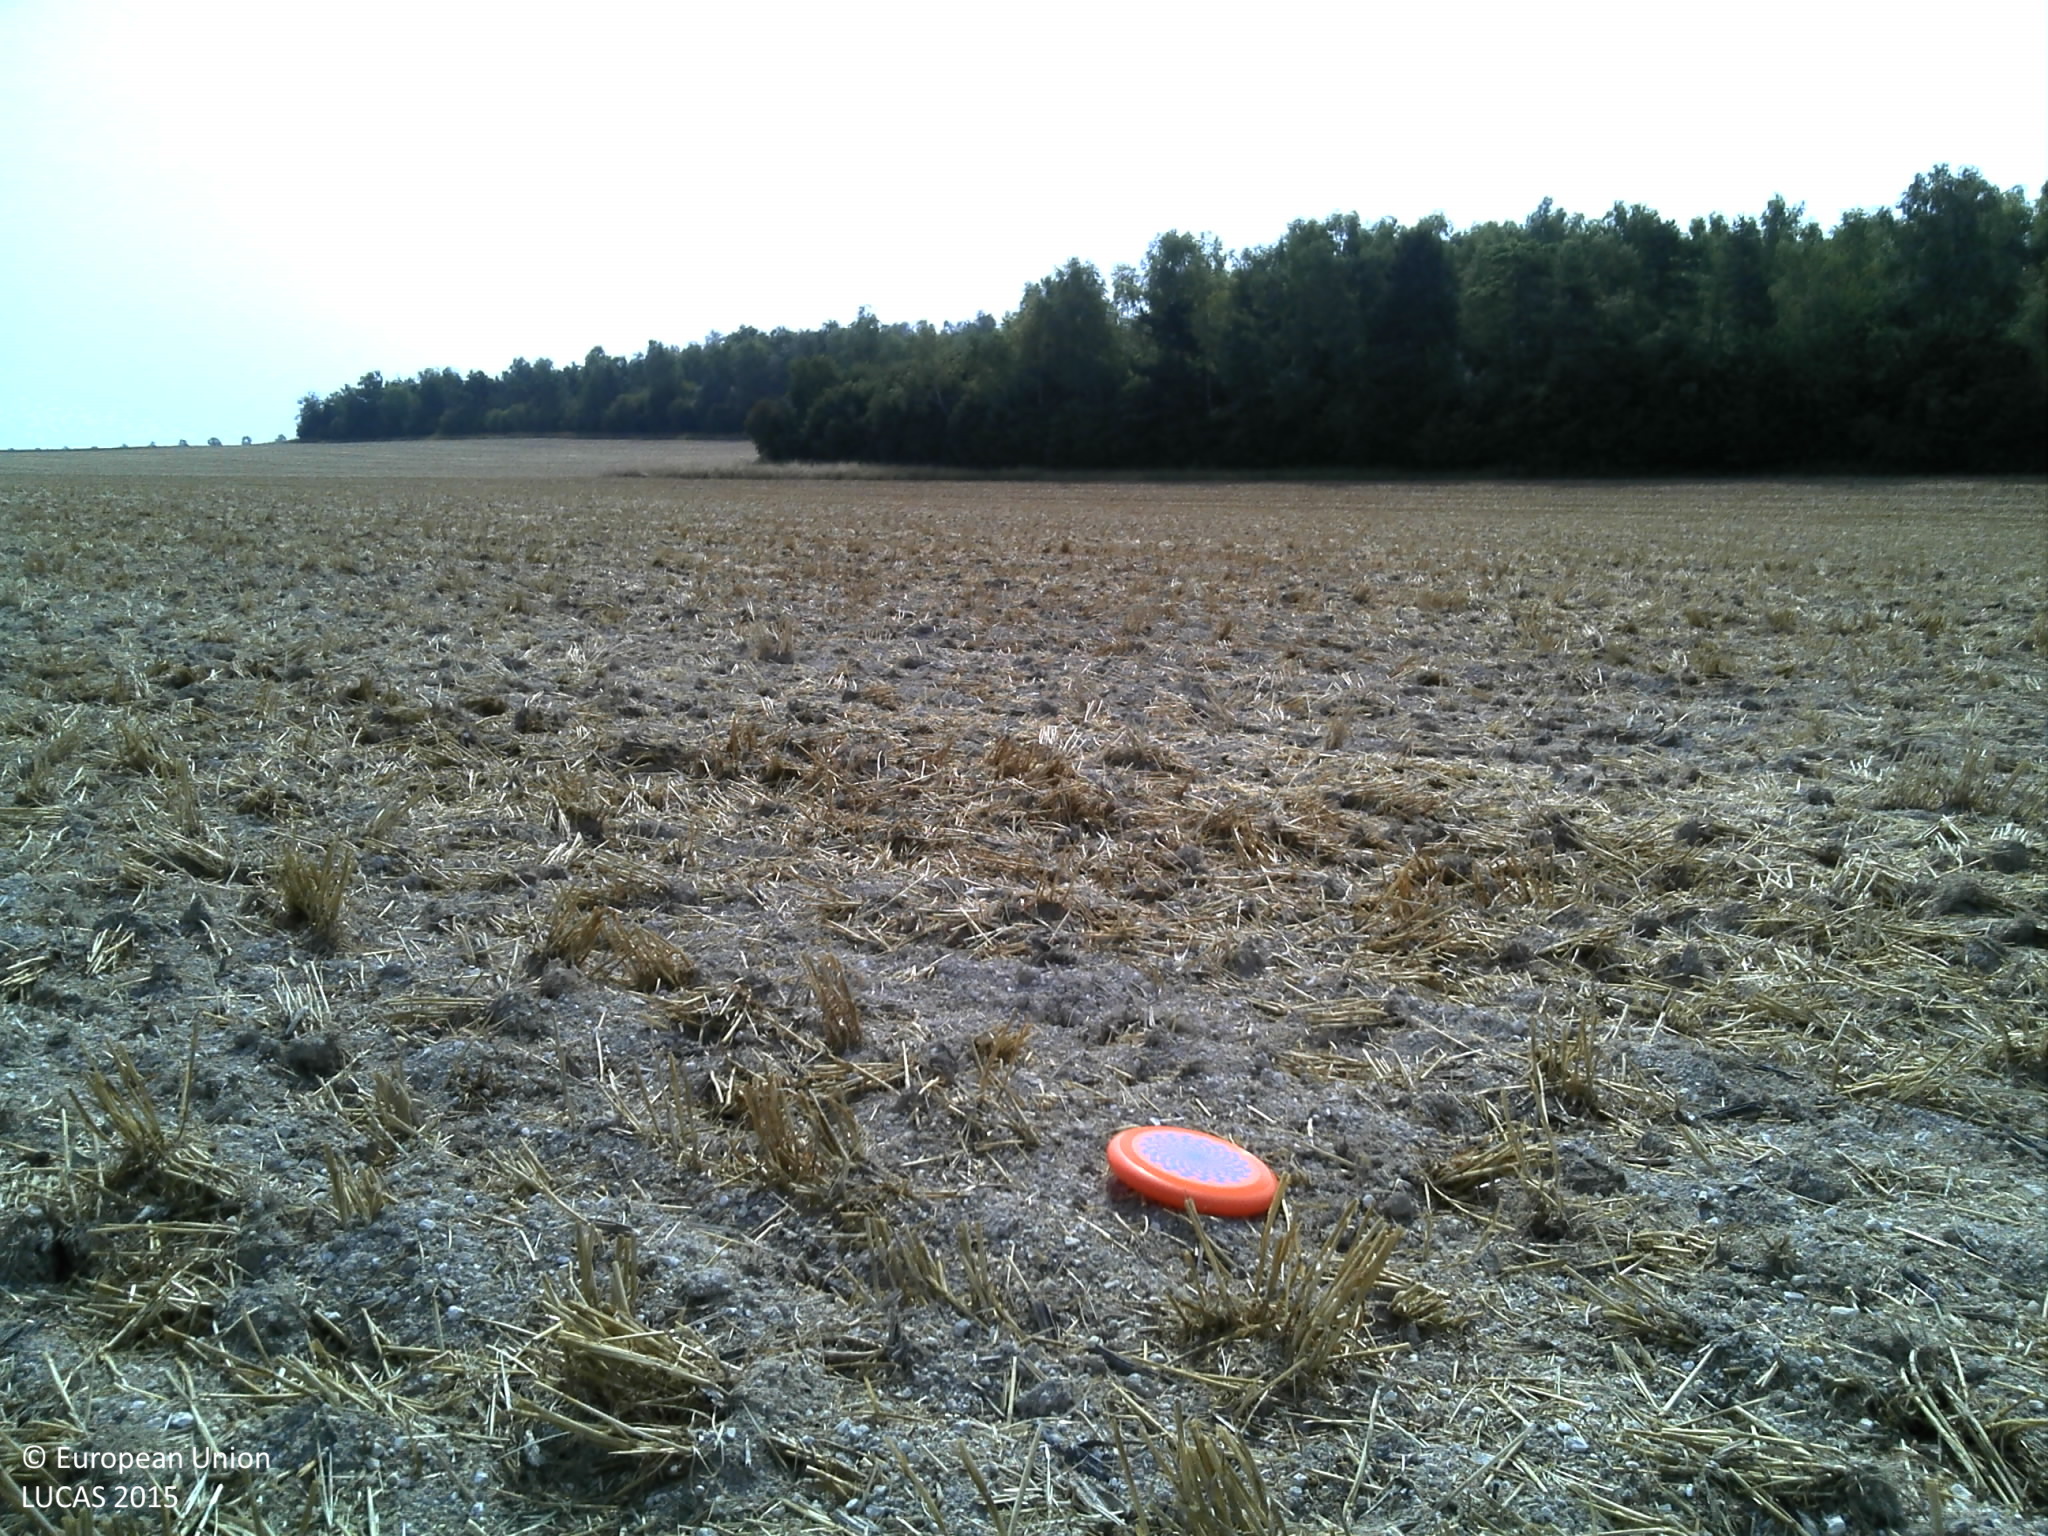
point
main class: Cropland
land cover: Common wheat
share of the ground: > 75 %
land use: Agriculture (excluding fallow land and kitchen gardens)
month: August
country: FR
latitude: 49.0492
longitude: 4.6472
